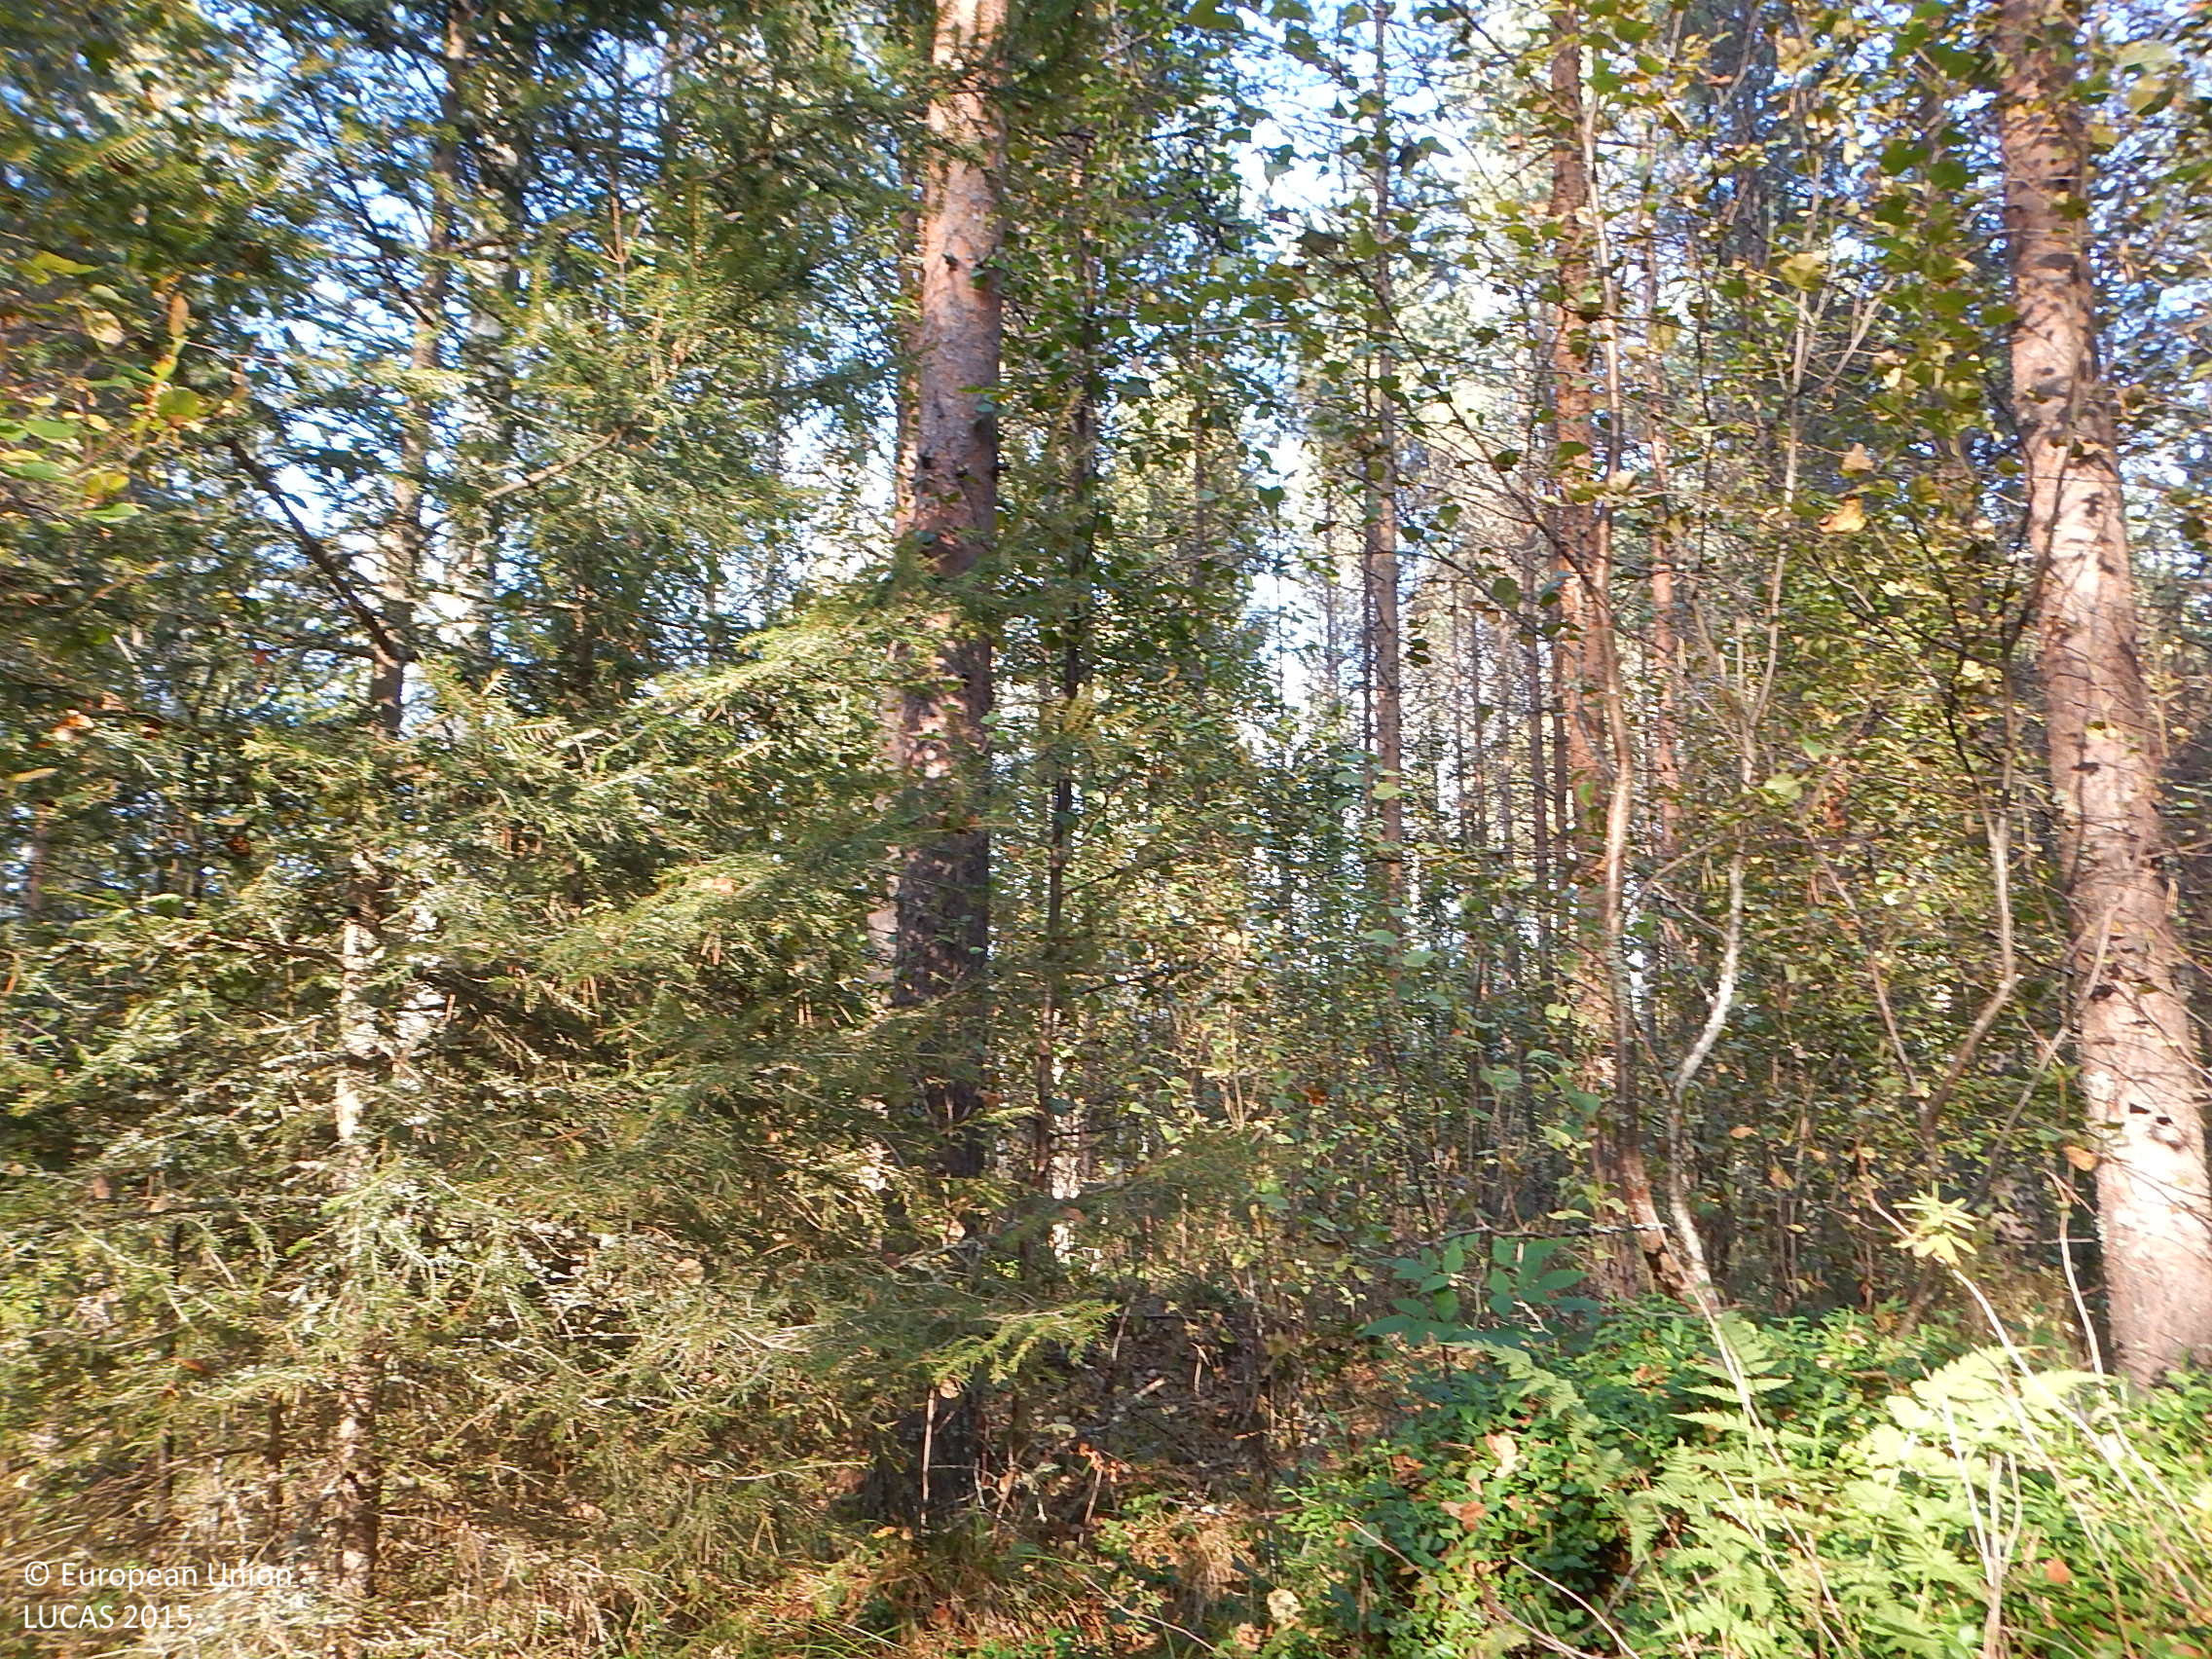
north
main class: Woodland
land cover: Other mixed woodland
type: boreal forest
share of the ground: > 75 %
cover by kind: coniferous forest trees 55 %, broadleaved forest trees 25 %, shrubs 10 %, herbaceous plants 5 %, lichens and mosses 5 %
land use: Forestry
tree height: > 5 m
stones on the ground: < 10 %
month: September
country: FI
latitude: 61.5740
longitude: 22.3196
